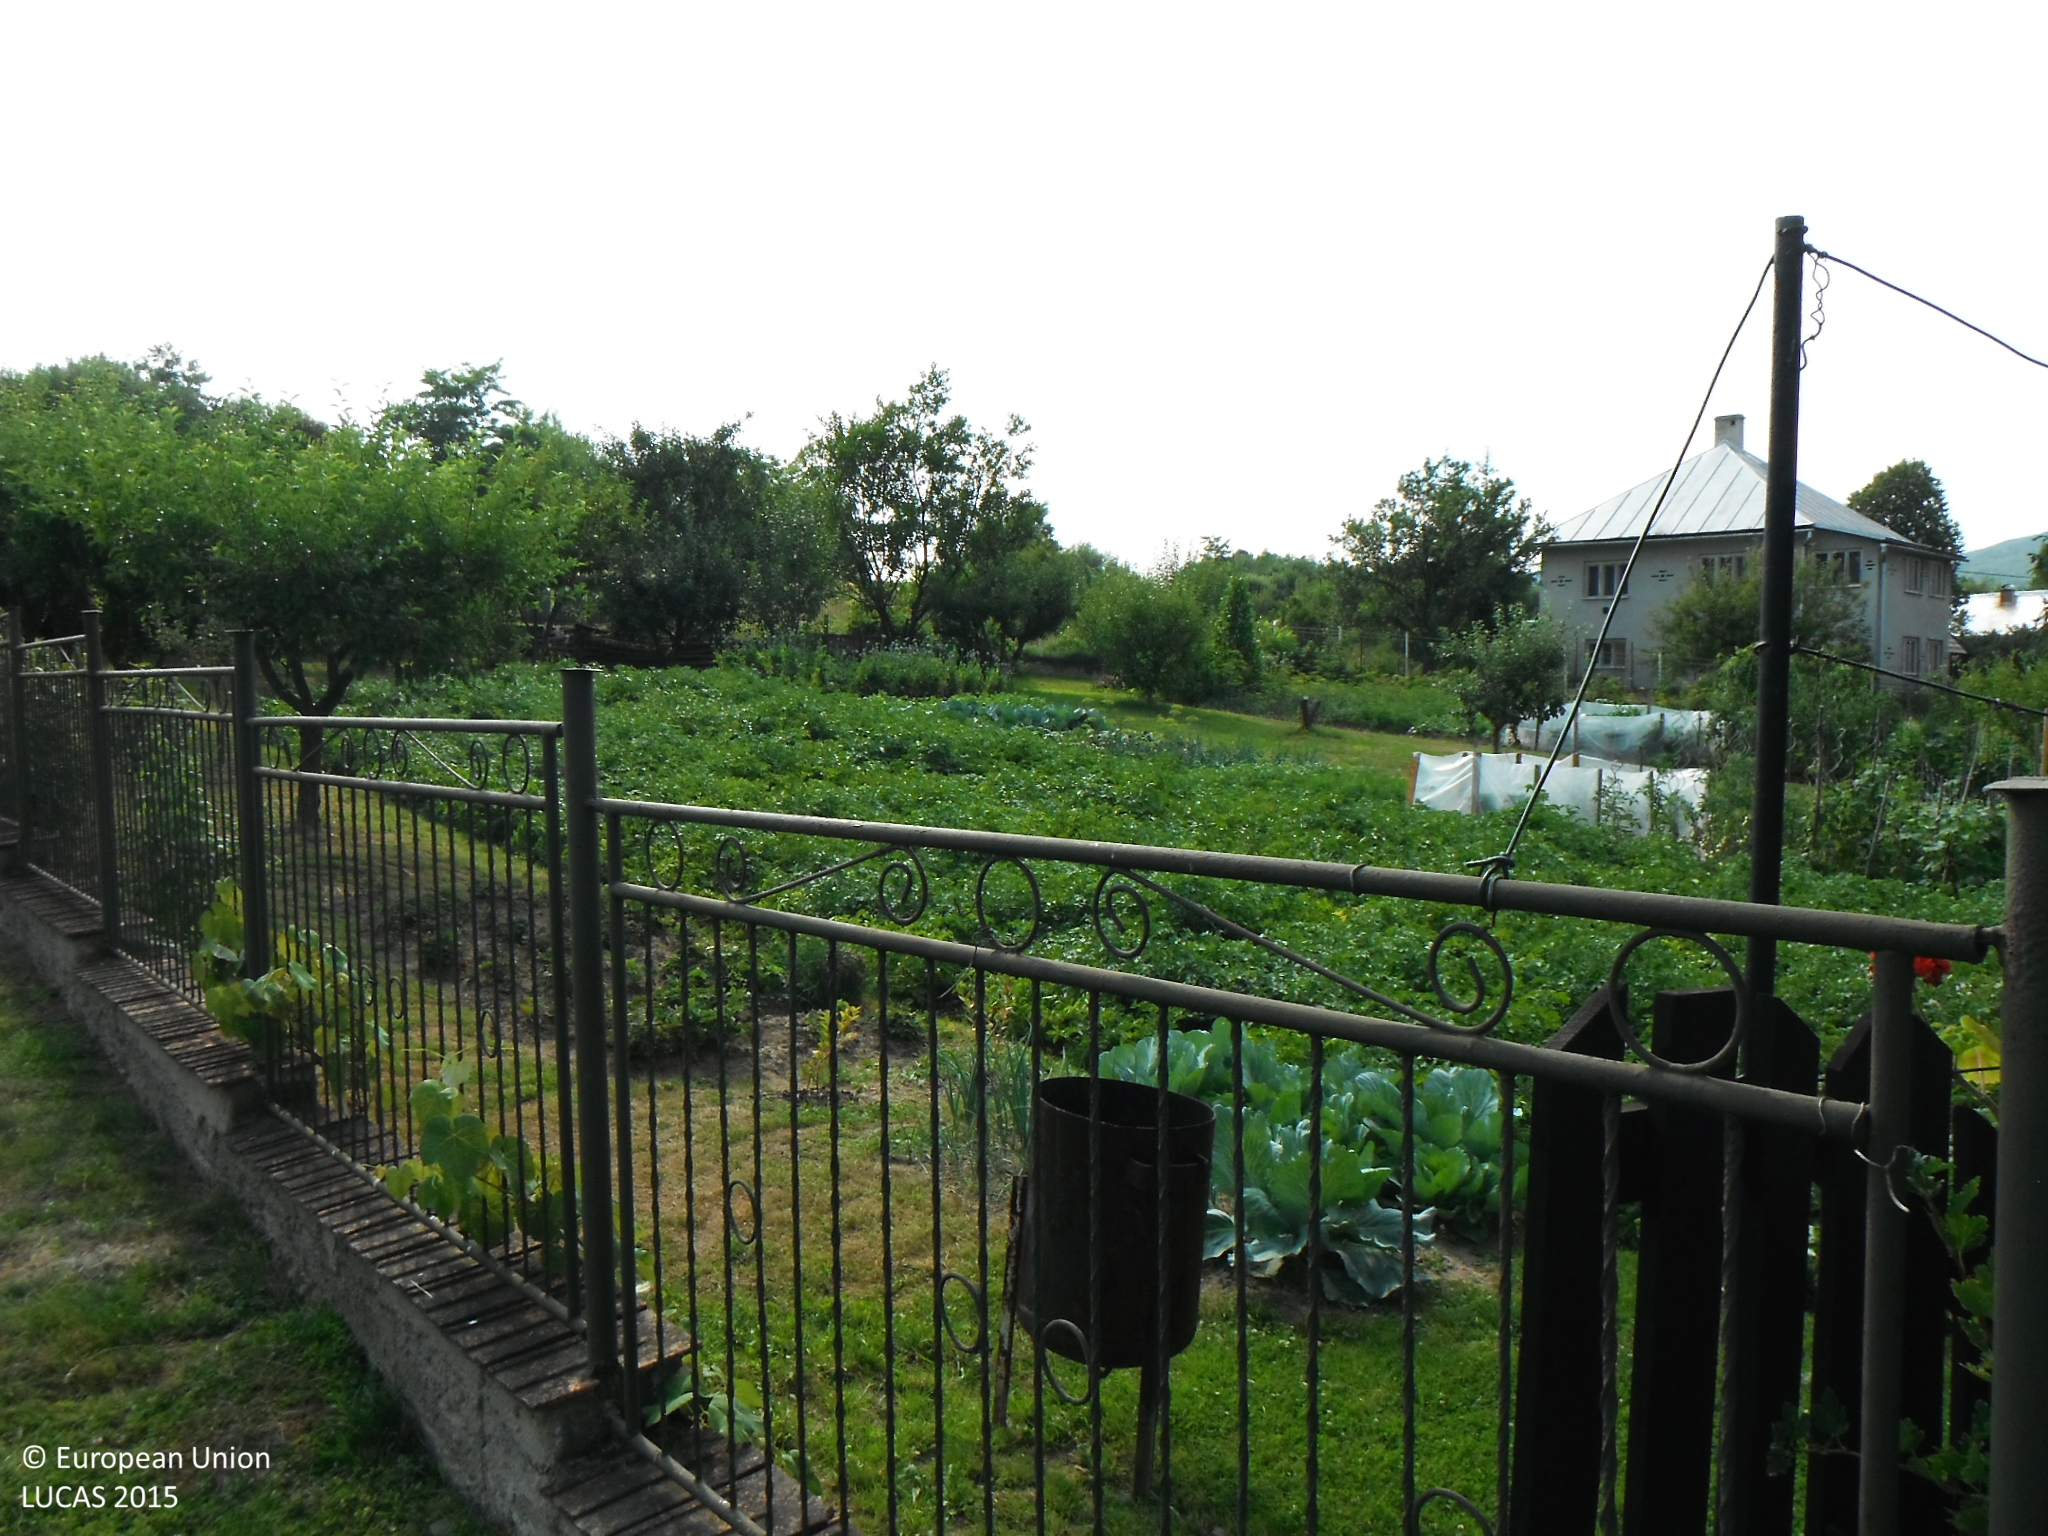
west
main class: Cropland
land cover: Apple fruit
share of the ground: 25 - 50 %
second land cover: Grassland without tree/shrub cover
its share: 50 - 75 %
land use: Kitchen garden
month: July
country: SK
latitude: 49.2994
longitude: 21.4206
